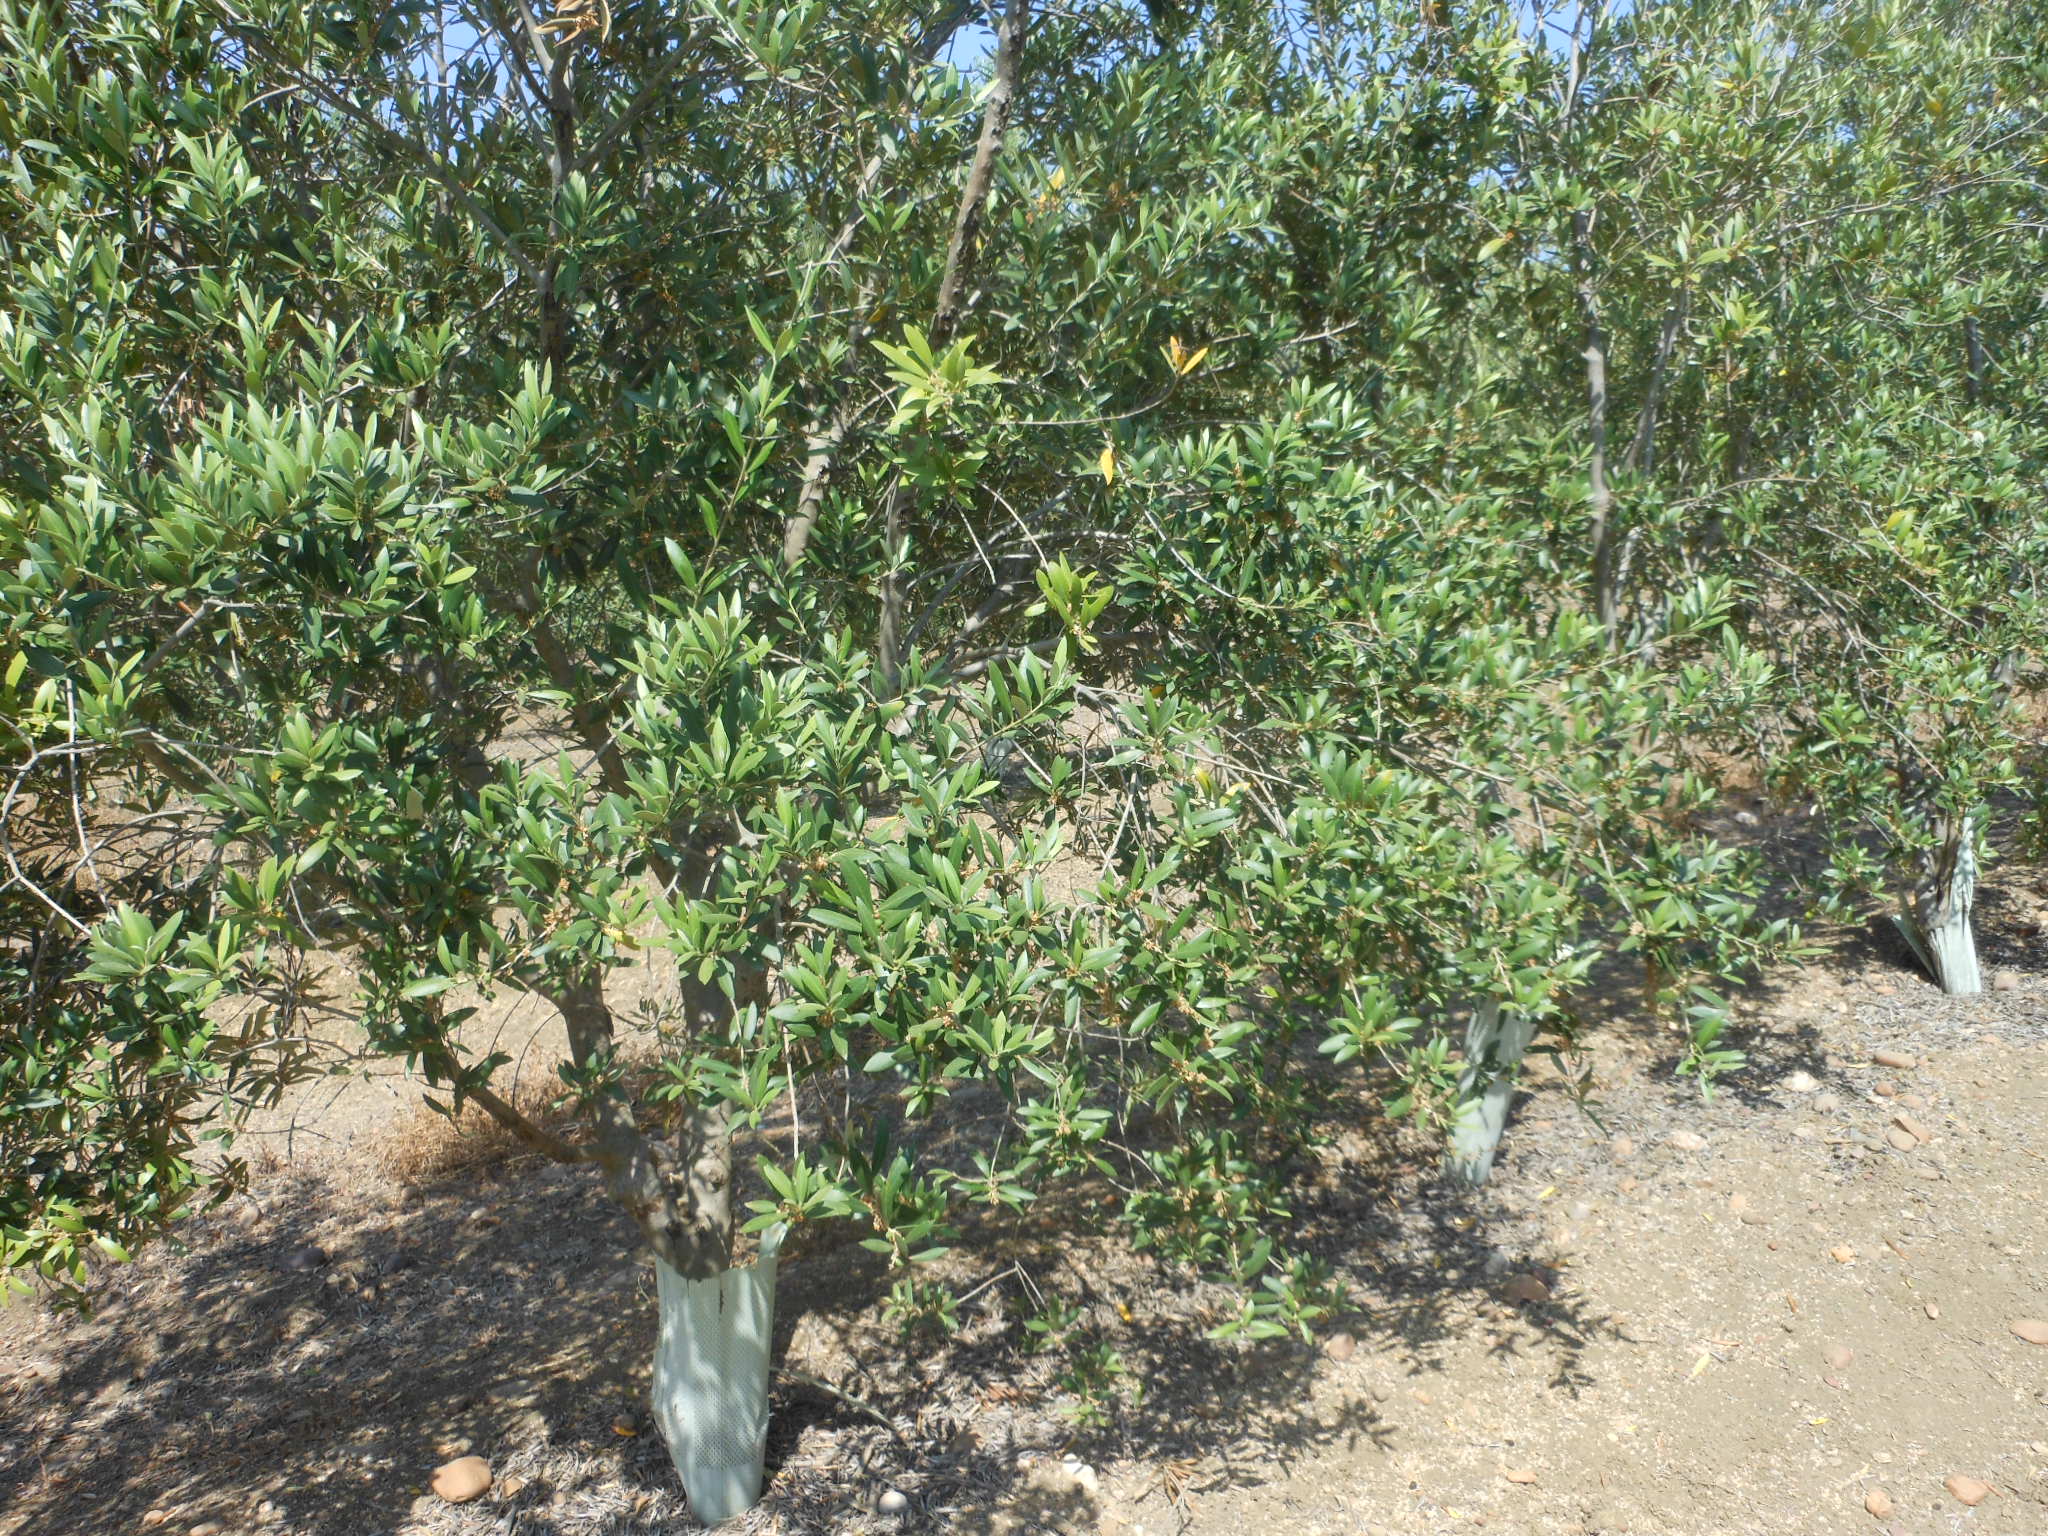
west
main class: Cropland
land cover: Olive groves
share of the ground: 50 - 75 %
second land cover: Other bare soil
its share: > 75 %
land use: Agriculture (excluding fallow land and kitchen gardens)
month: May
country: ES
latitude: 37.5530
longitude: -5.4007
